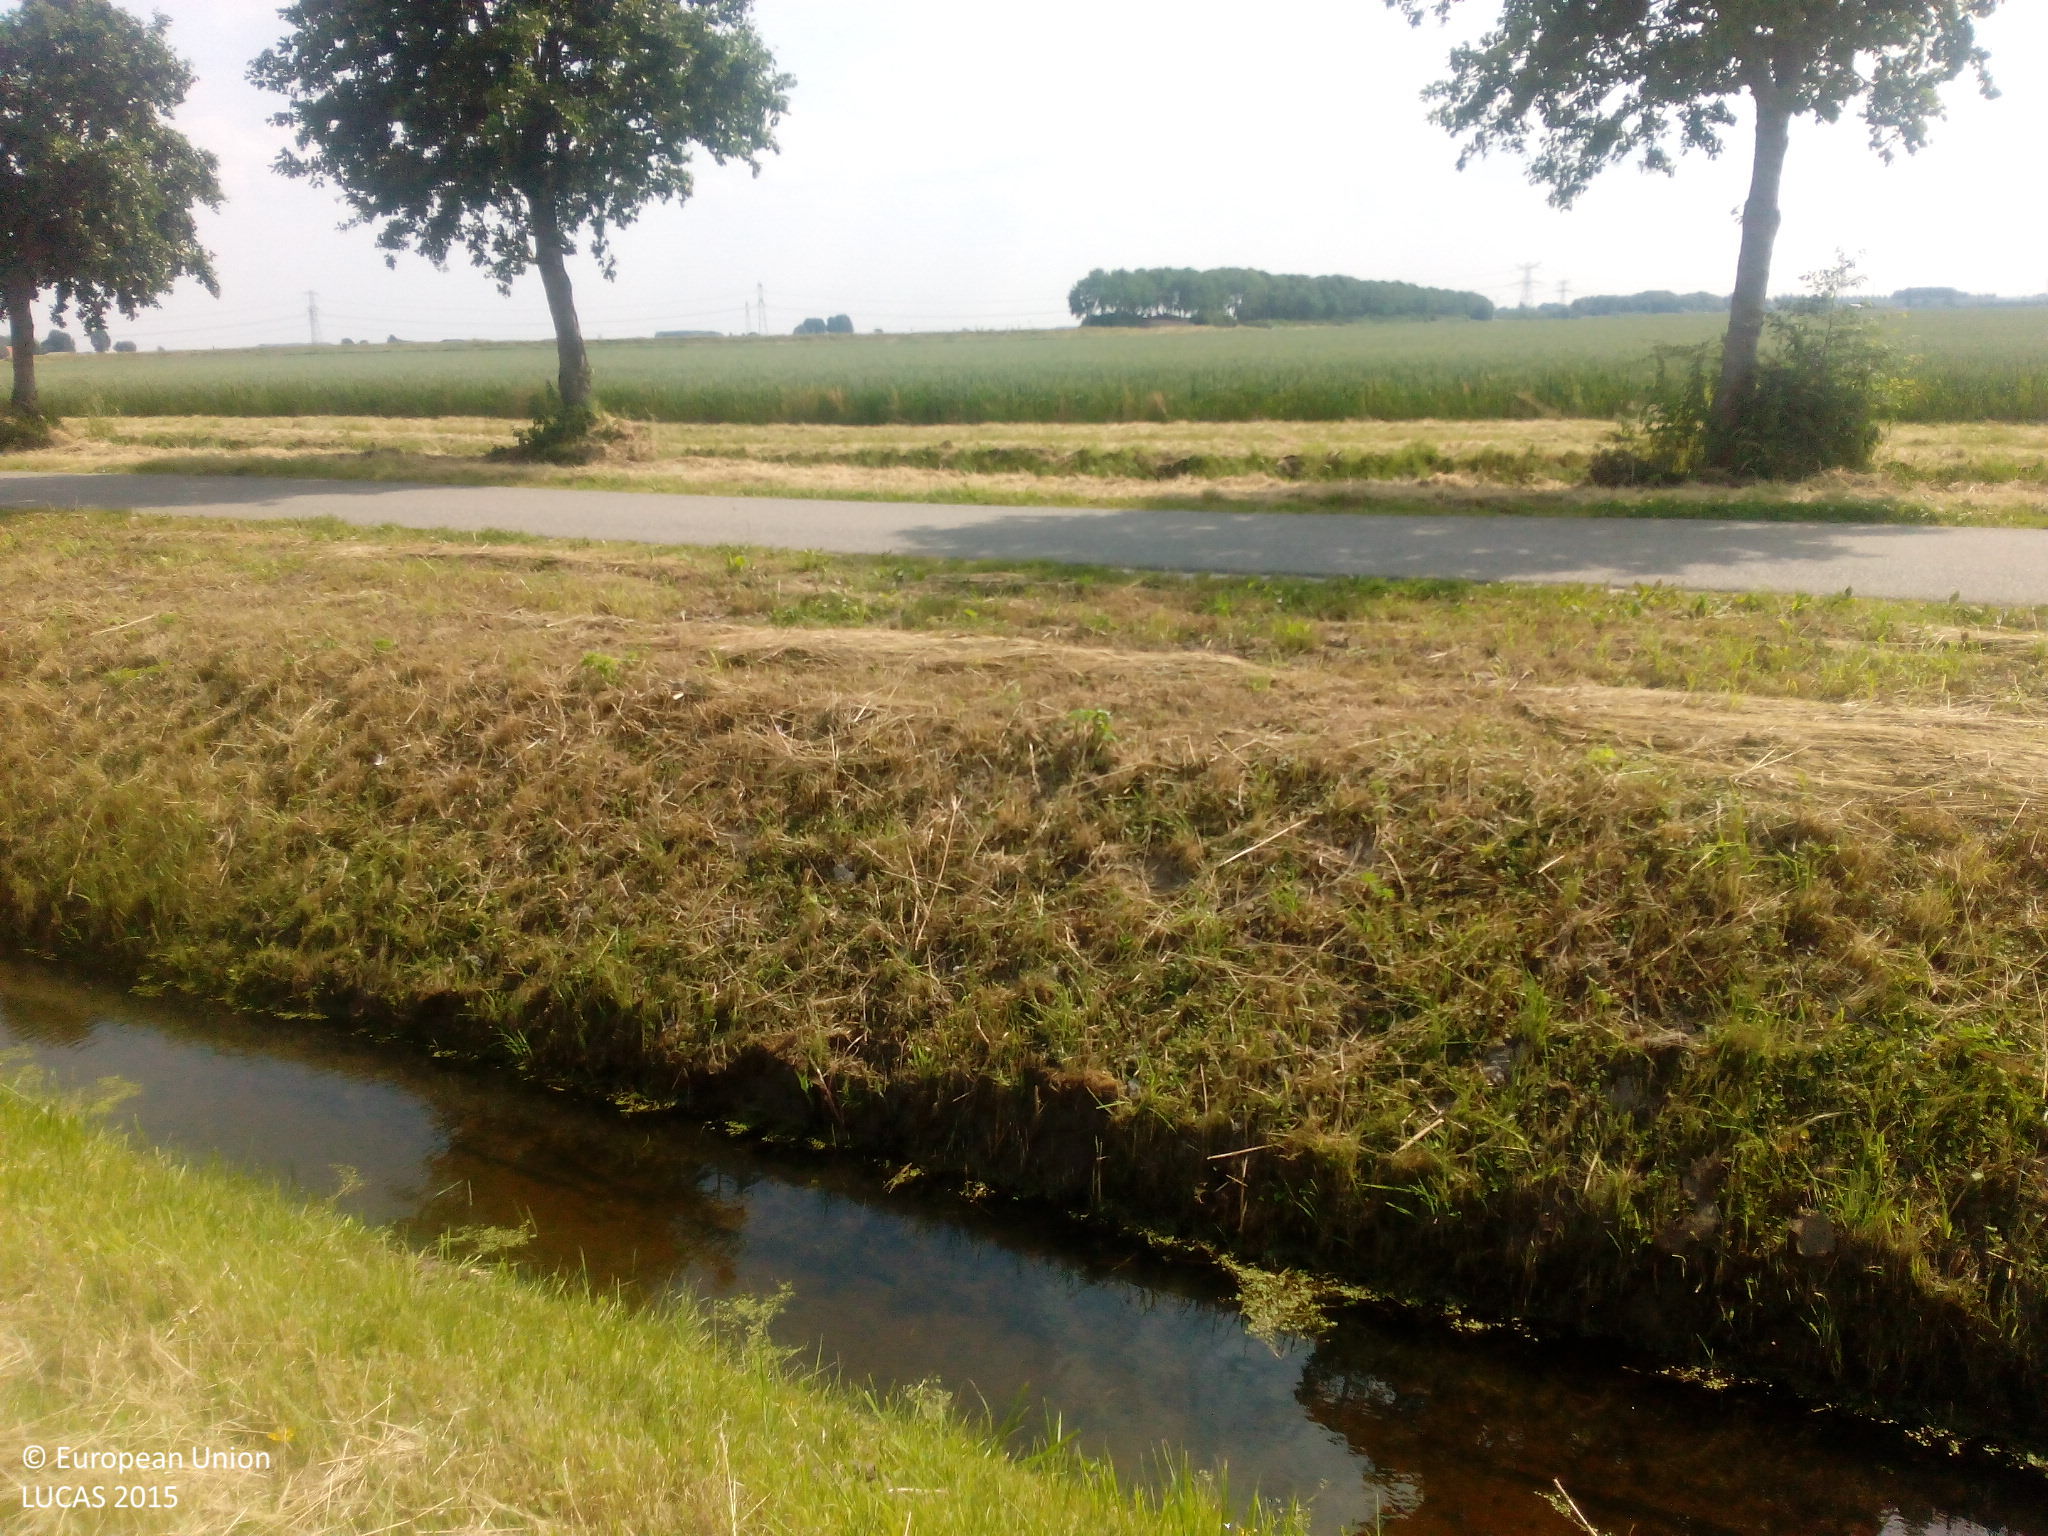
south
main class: Grassland
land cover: Grassland without tree/shrub cover
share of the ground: > 75 %
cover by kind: herbaceous plants 90 %, consolidated bare surface 10 %
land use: Agriculture (excluding fallow land and kitchen gardens)
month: June
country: NL
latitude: 51.7001
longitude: 4.6862
